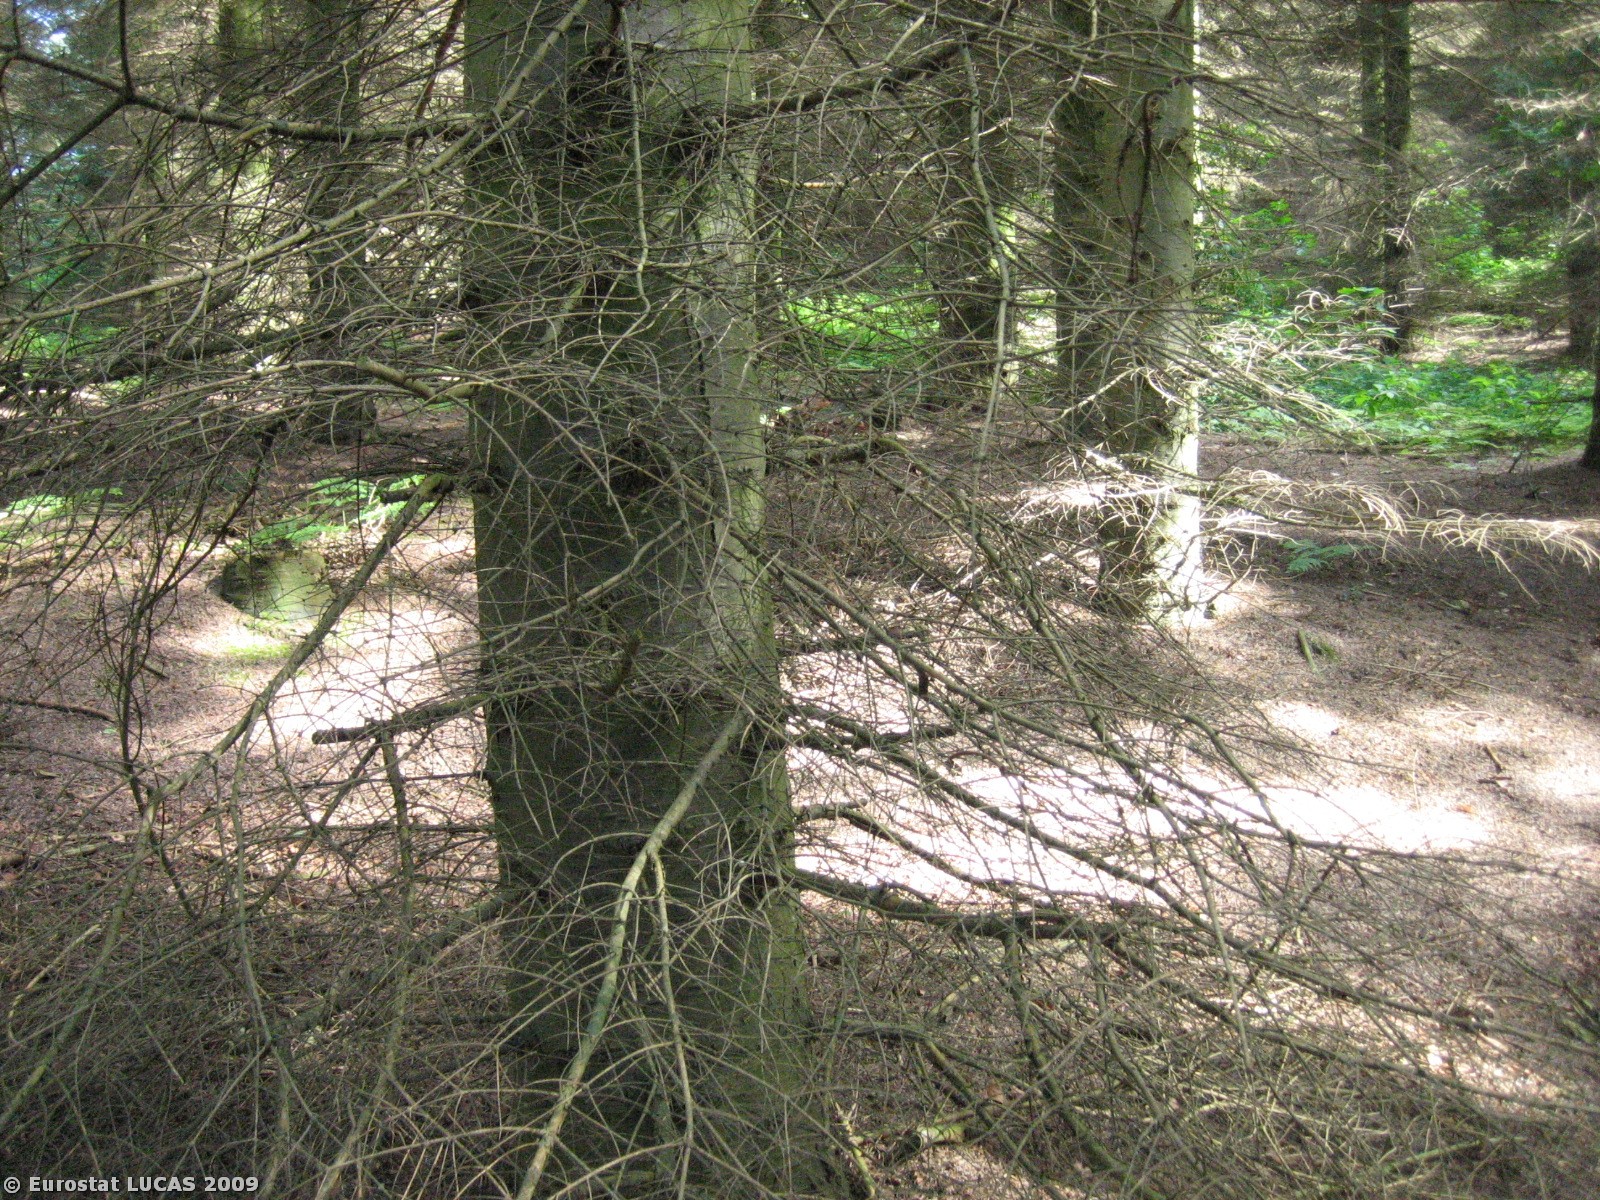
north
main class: Woodland
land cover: Coniferous woodland
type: hemiboreal forest and nemoral coniferous forest and mixed broadleaved-coniferous forest
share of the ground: > 75 %
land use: Forestry
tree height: > 5 m
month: June
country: DK
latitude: 55.7922
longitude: 9.8566
